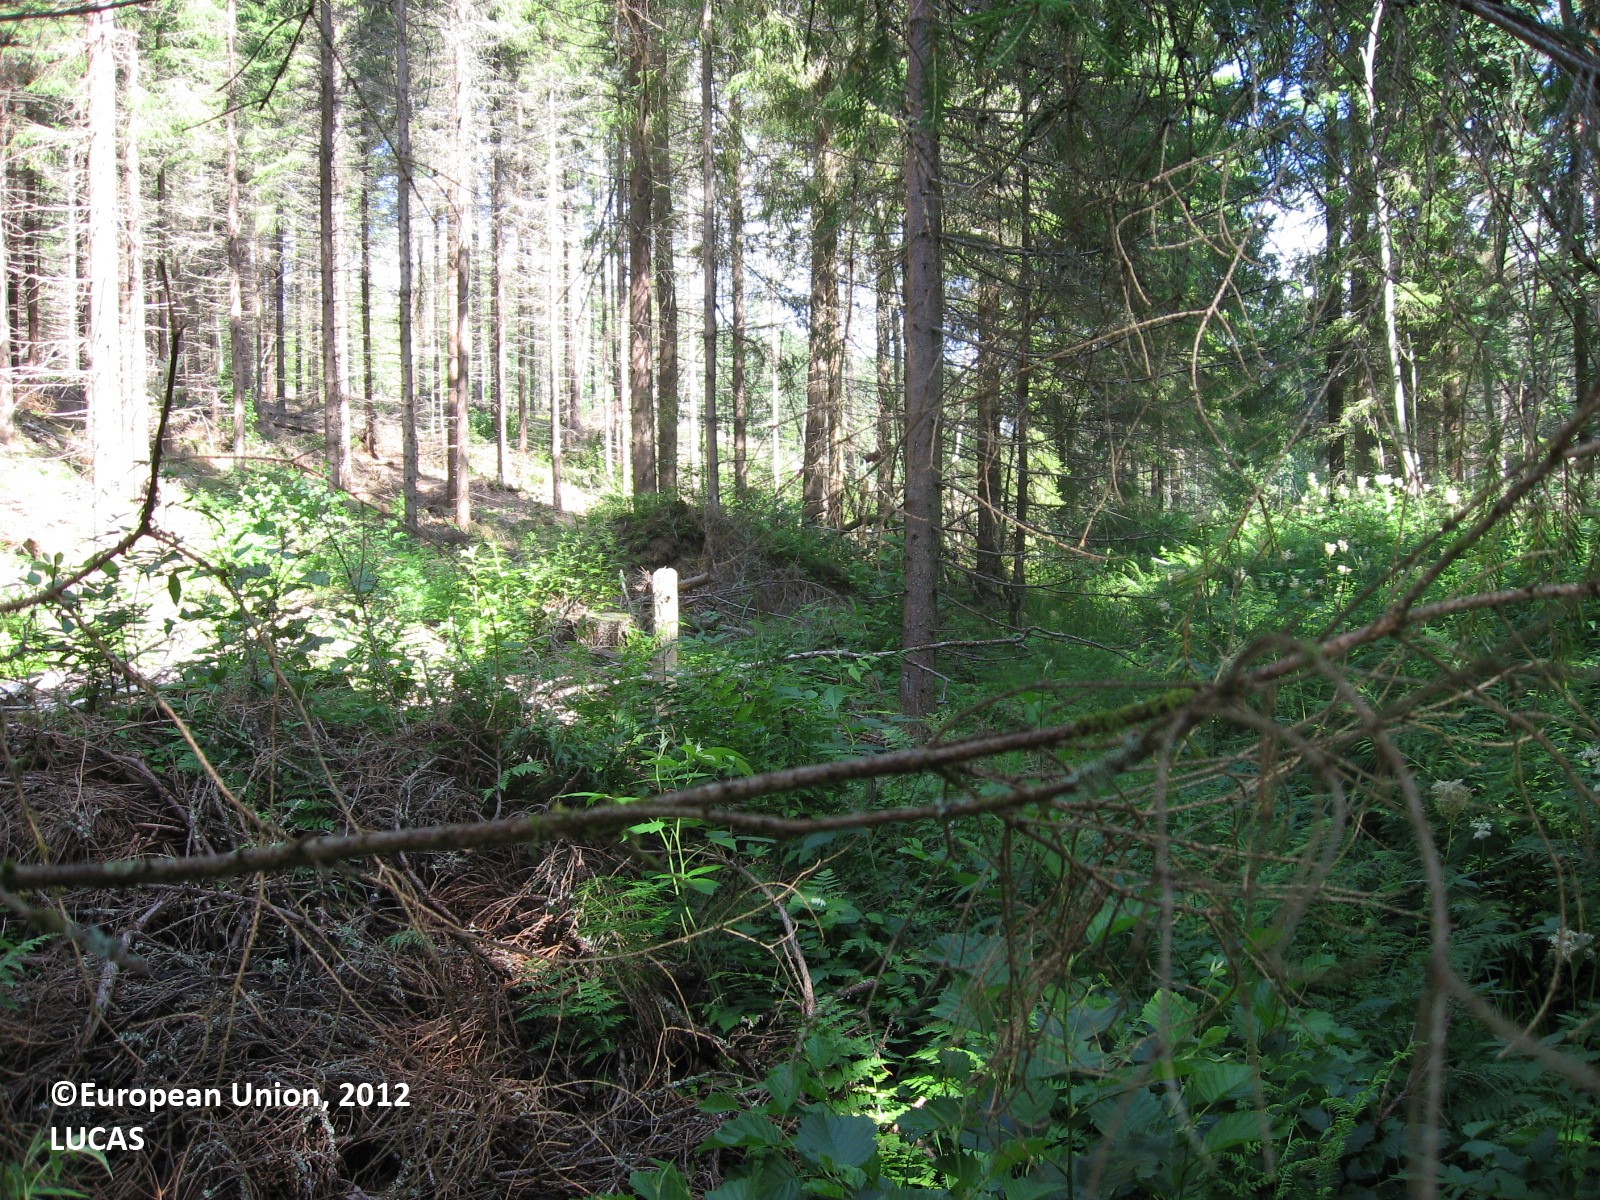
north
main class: Woodland
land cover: Spruce dominated coniferous woodland
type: boreal forest
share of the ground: > 75 %
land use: Forestry
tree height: > 5 m
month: July
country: FI
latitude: 61.1517
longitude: 25.7177
